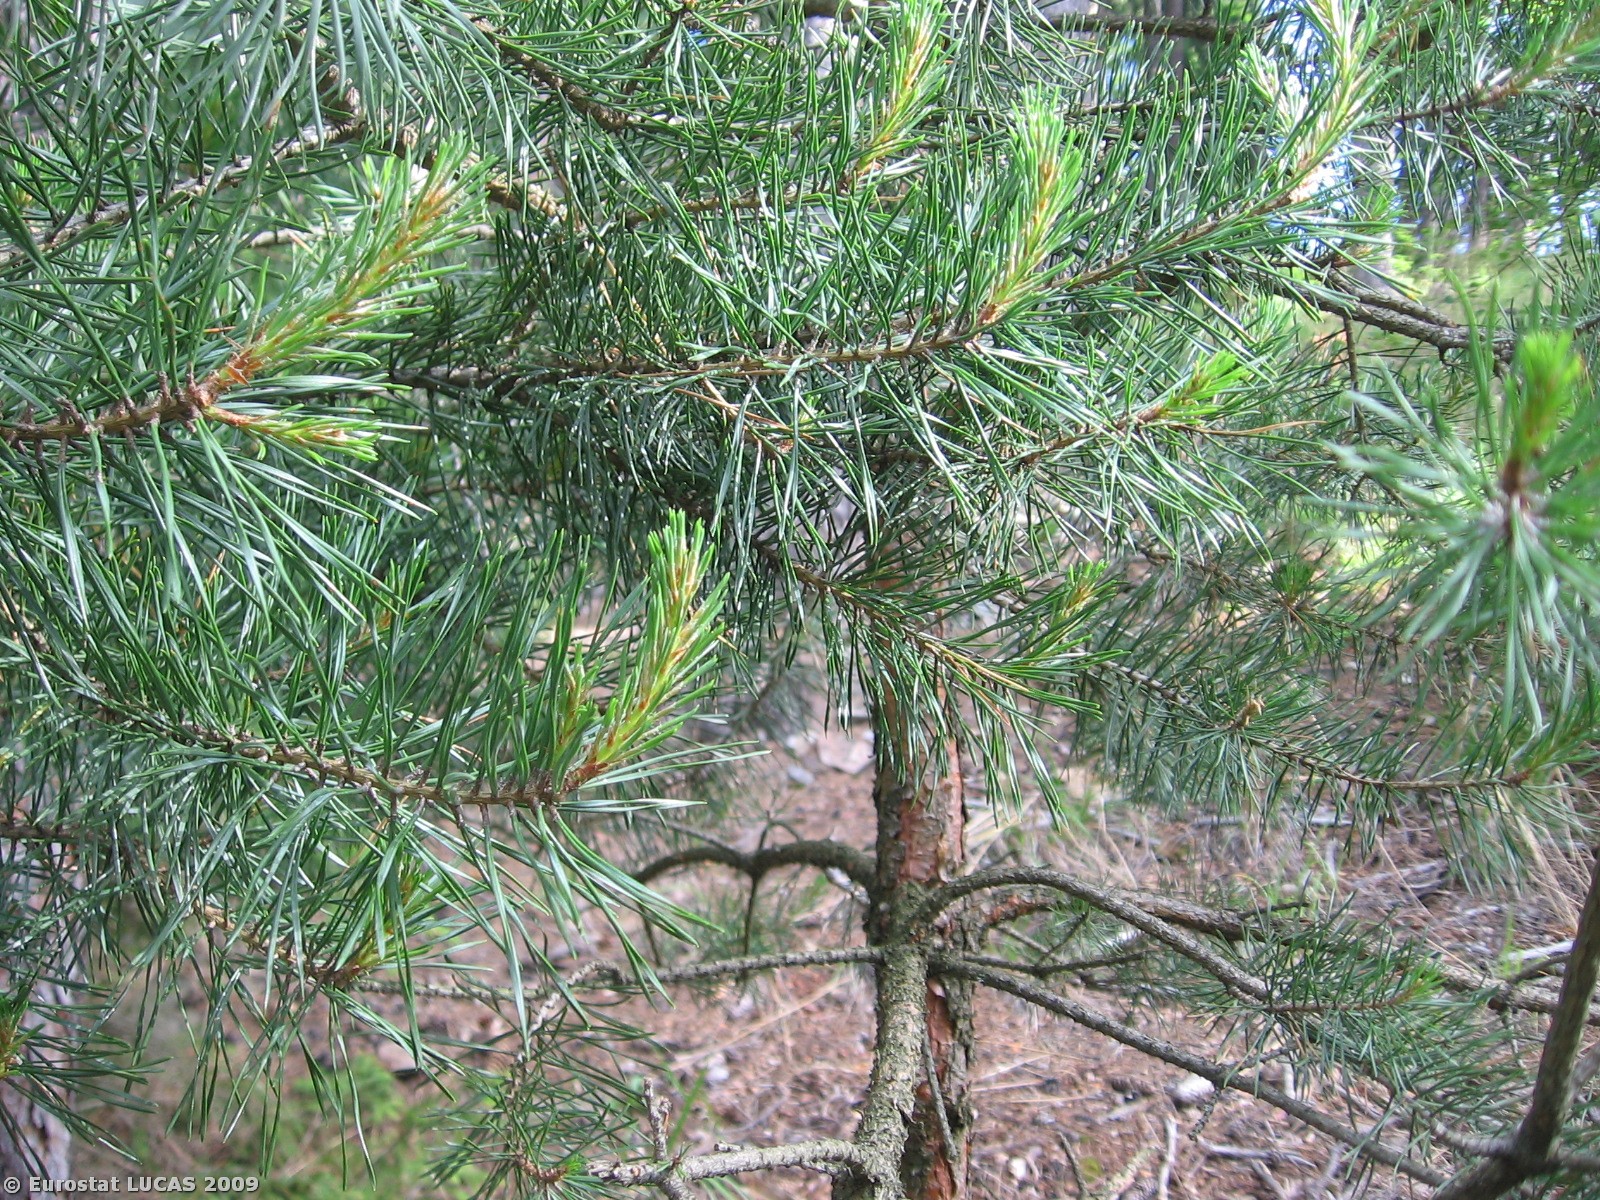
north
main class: Woodland
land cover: Coniferous woodland
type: hemiboreal forest and nemoral coniferous forest and mixed broadleaved-coniferous forest
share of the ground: > 75 %
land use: Forestry
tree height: > 5 m
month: June
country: CZ
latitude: 49.1289
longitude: 13.8513
